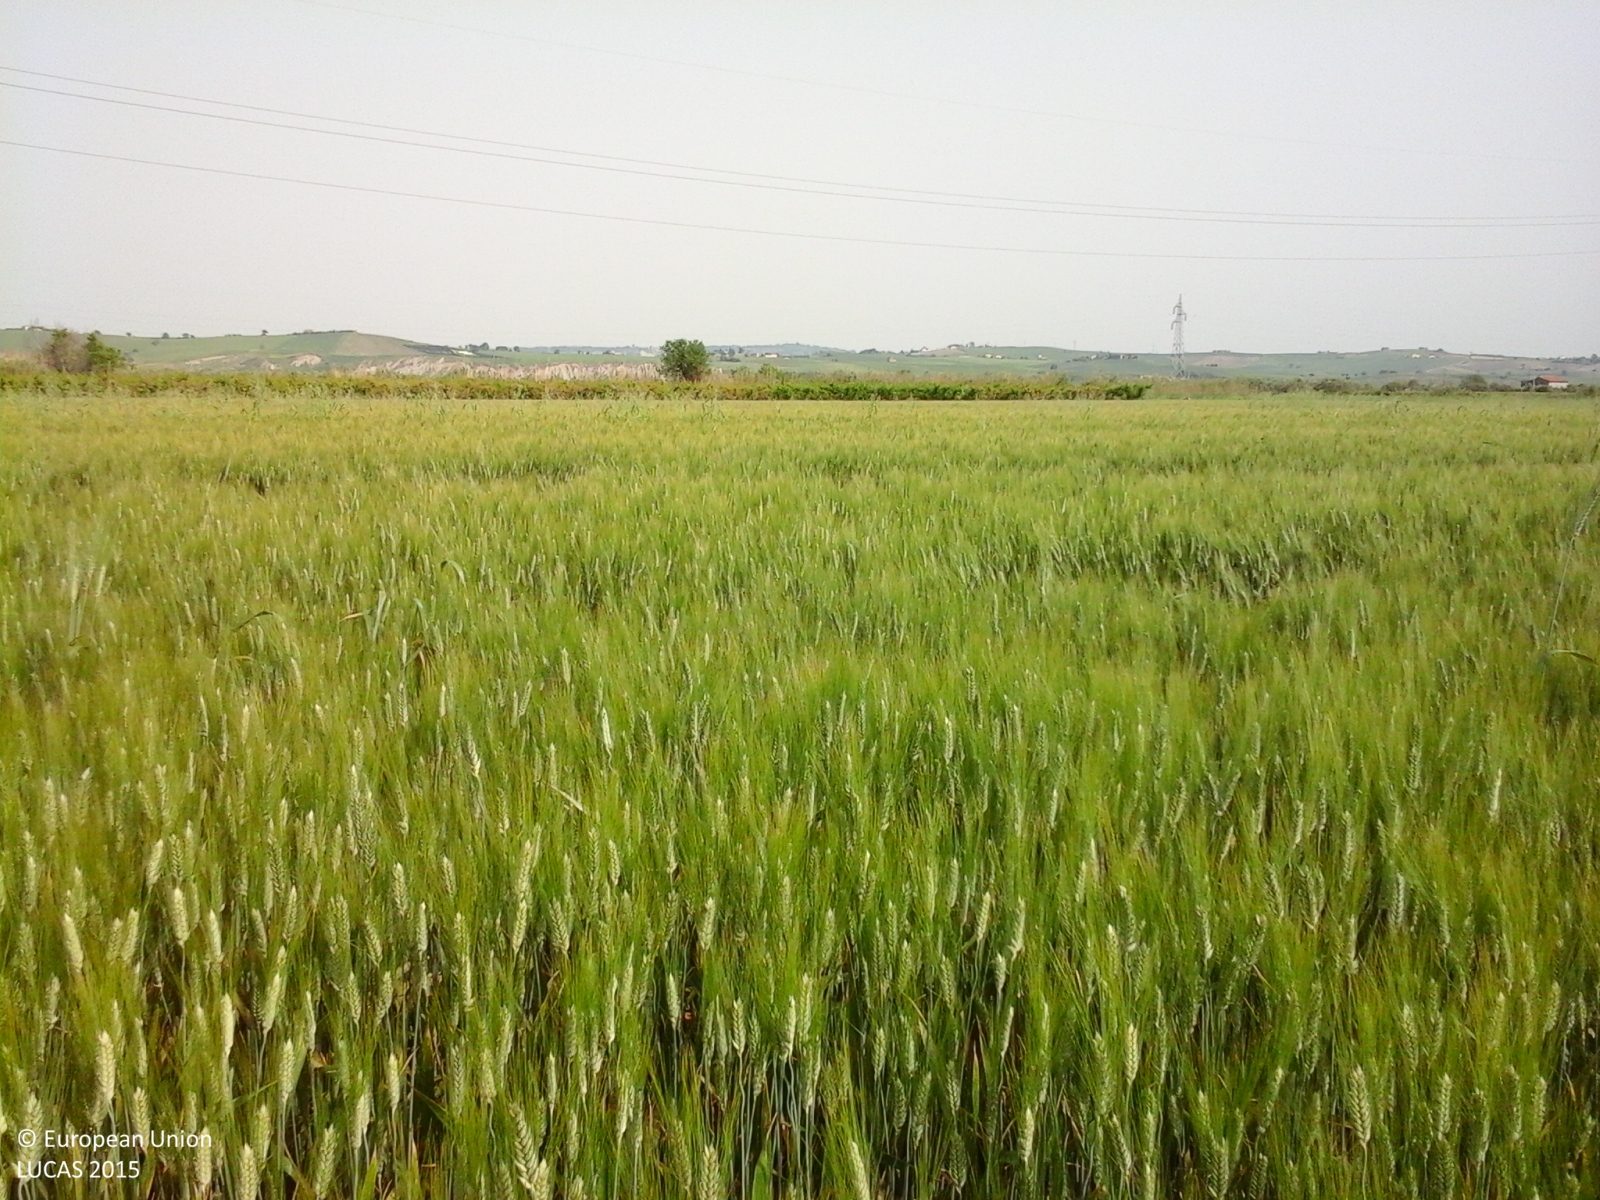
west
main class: Cropland
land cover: Durum wheat
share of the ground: > 75 %
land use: Agriculture (excluding fallow land and kitchen gardens)
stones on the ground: < 10 %
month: May
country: IT
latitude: 42.0357
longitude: 14.7567
